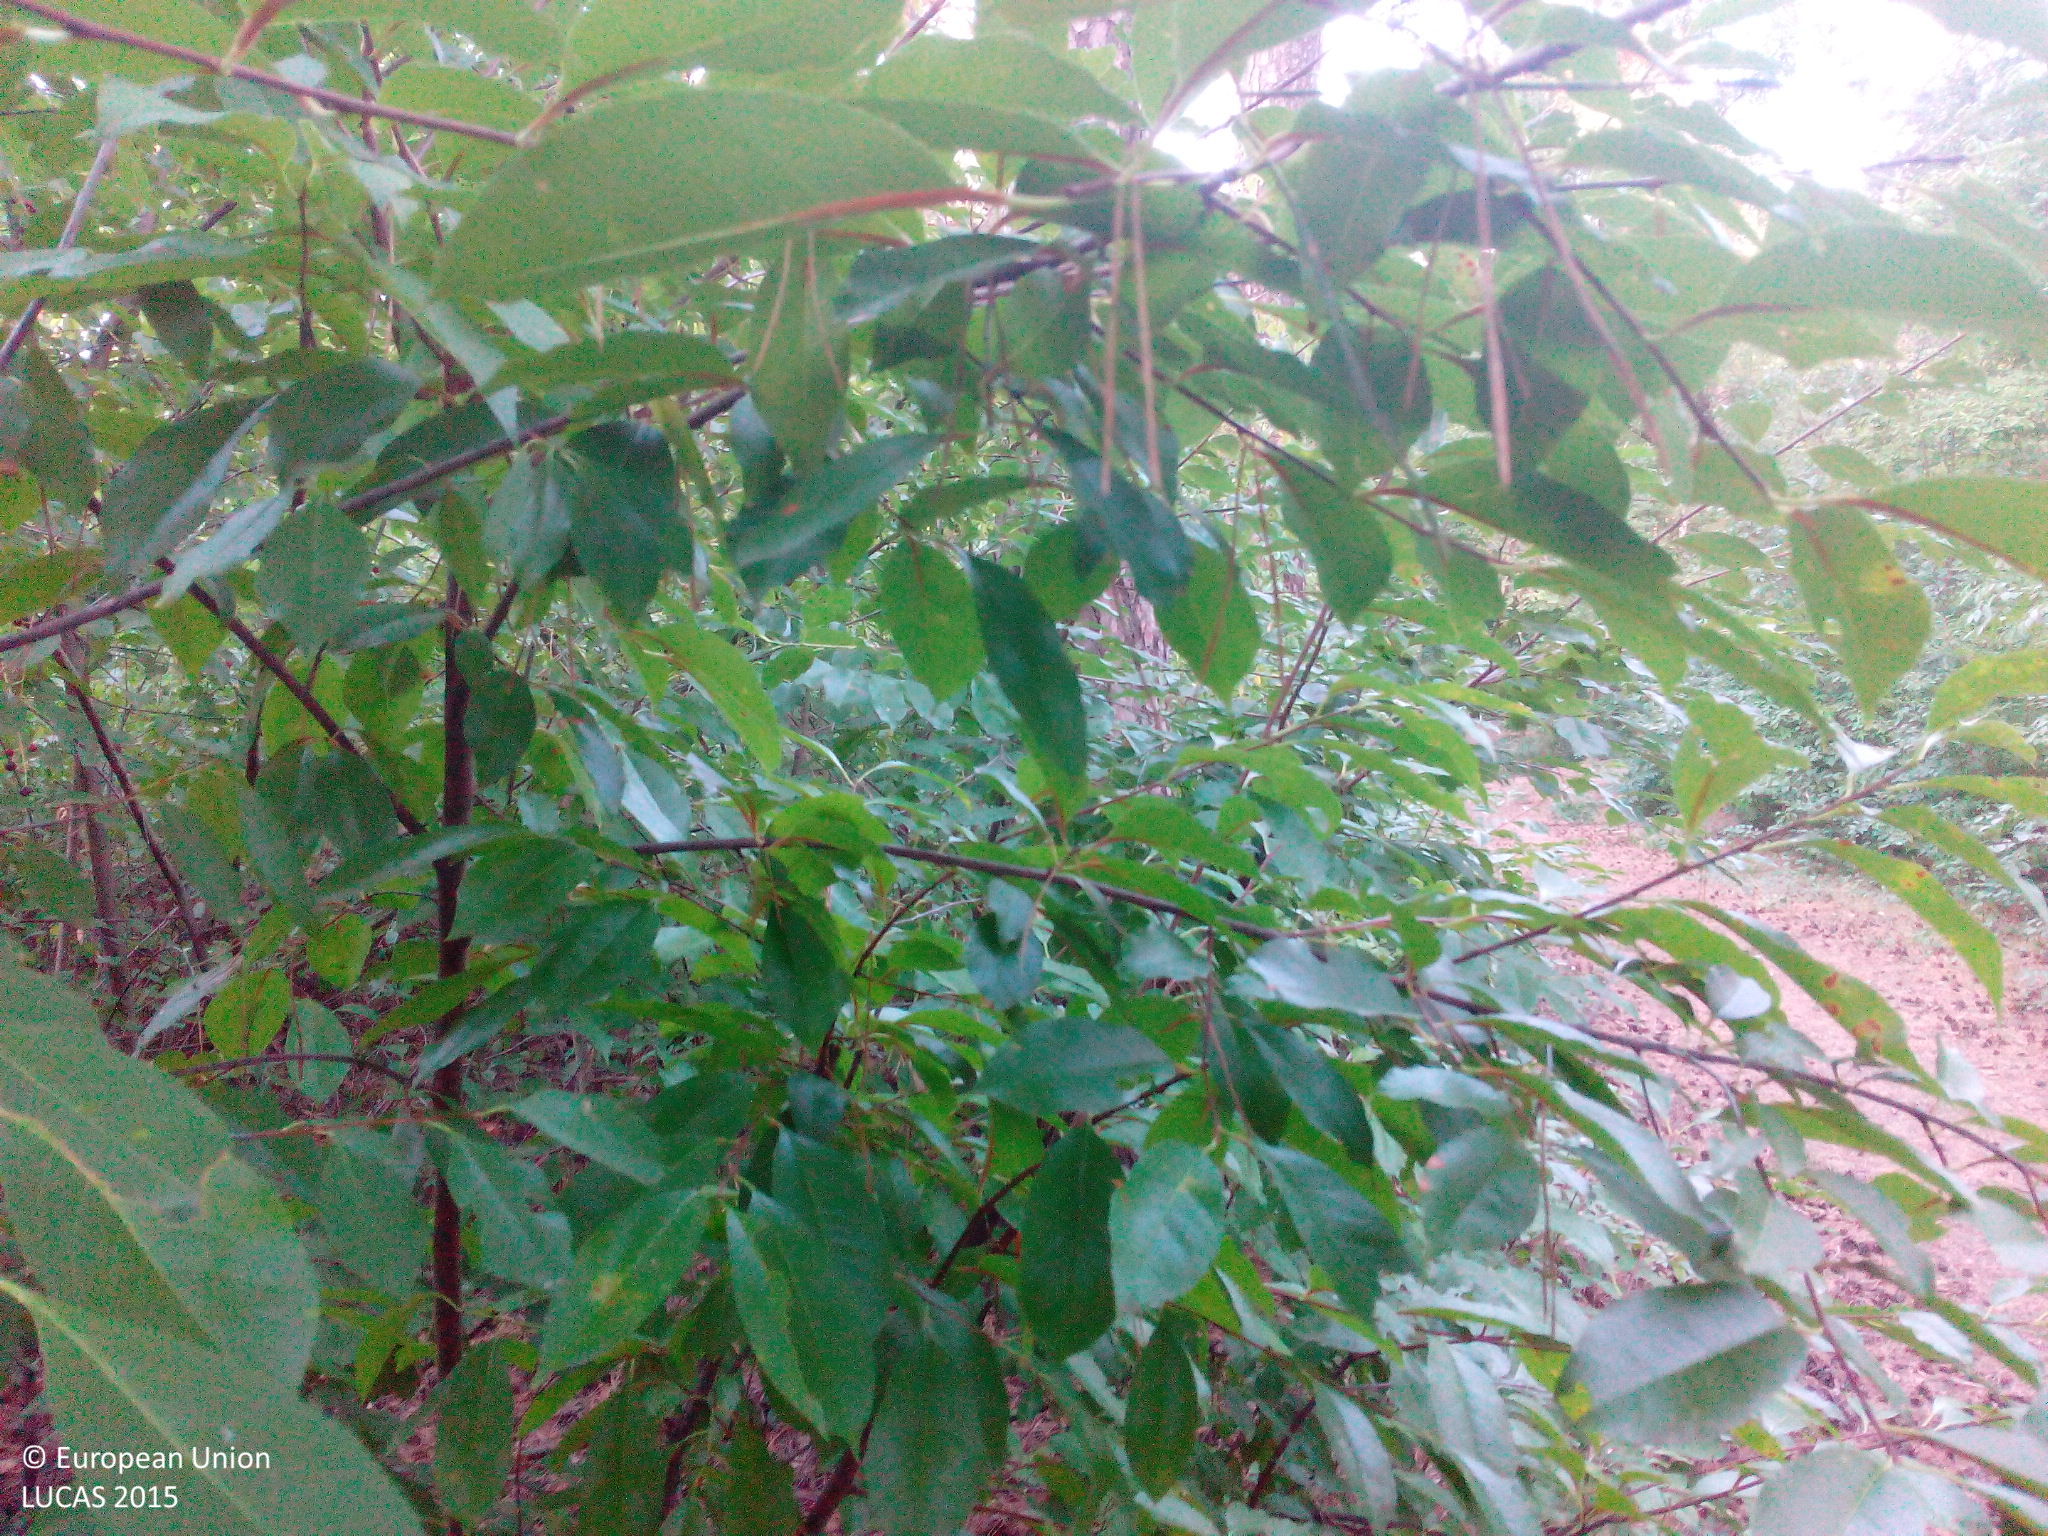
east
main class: Woodland
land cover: Pine dominated mixed woodland
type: hemiboreal forest and nemoral coniferous forest and mixed broadleaved-coniferous forest
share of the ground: 50 - 75 %
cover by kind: shrubs 40 %, broadleaved forest trees 30 %, coniferous forest trees 20 %, unconsolidated bare surface 10 %
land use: Forestry
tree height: > 5 m
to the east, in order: Pine dominated mixed woodland; Tracks; Pine dominated mixed woodland
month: August
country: DE
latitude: 49.4376
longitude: 8.5525
